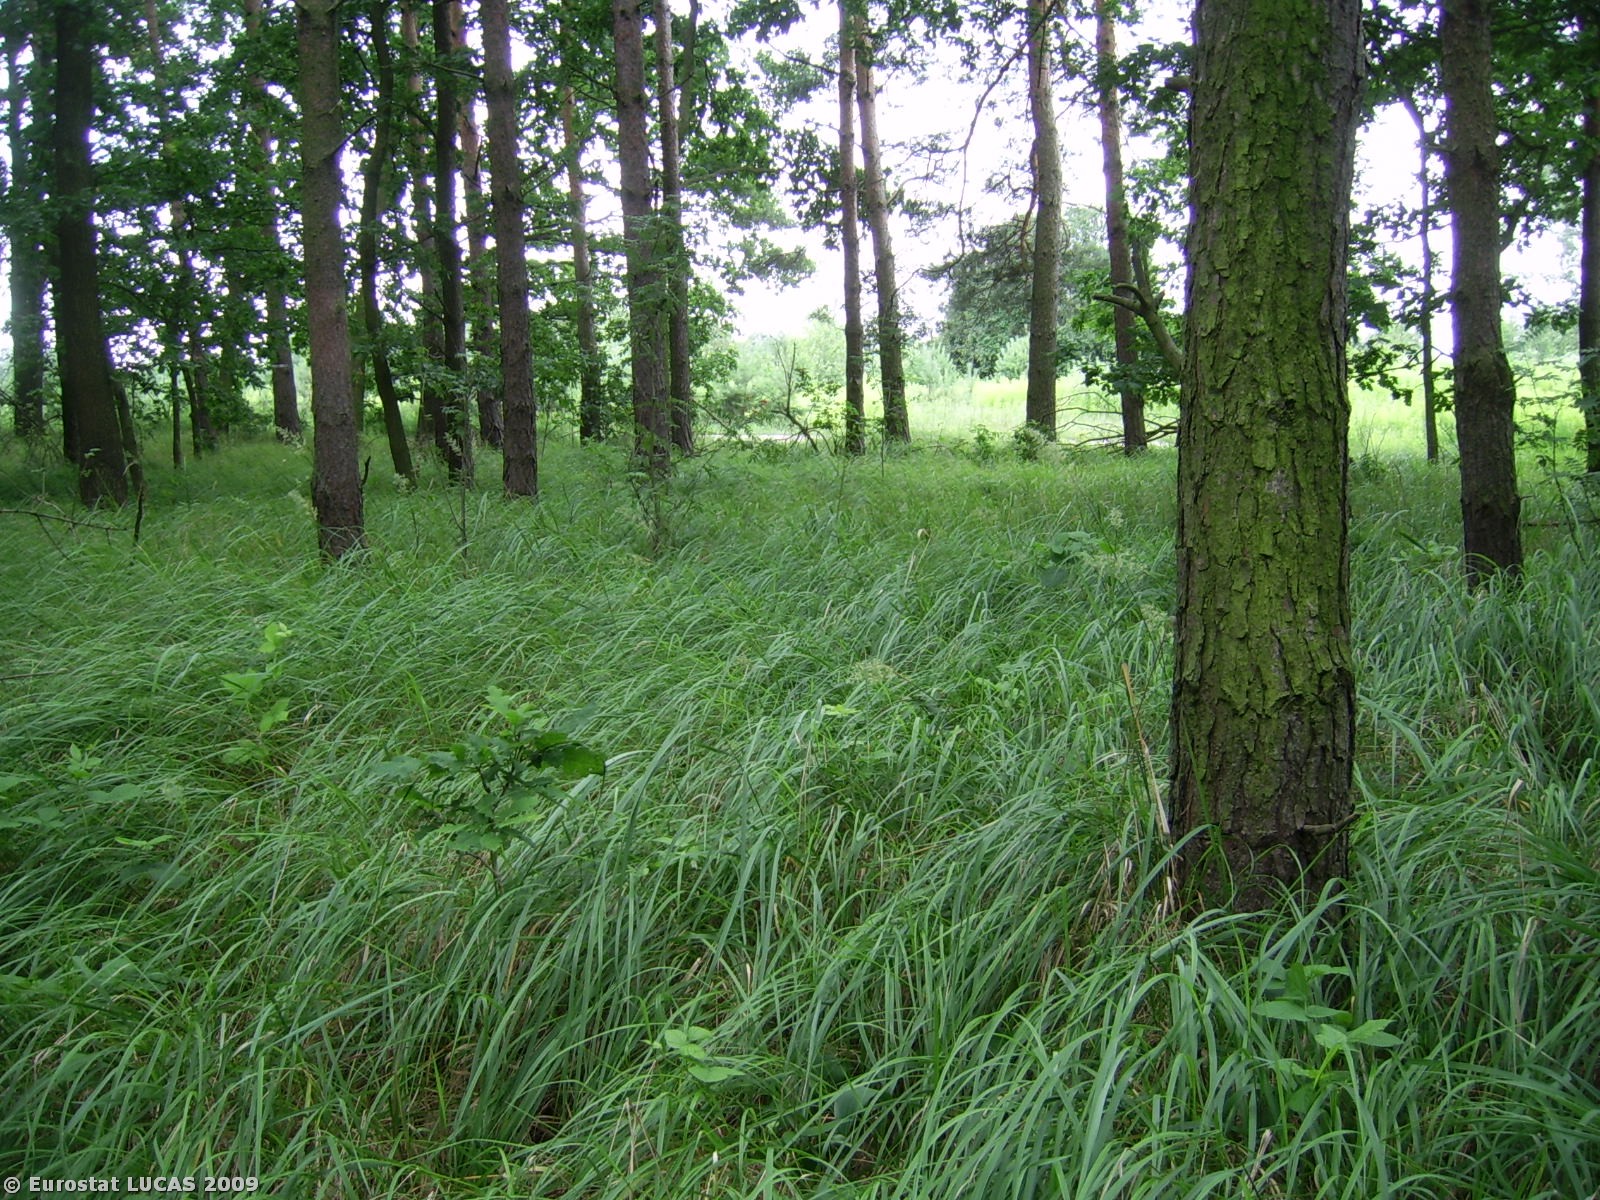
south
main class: Woodland
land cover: Mixed woodland
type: hemiboreal forest and nemoral coniferous forest and mixed broadleaved-coniferous forest
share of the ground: 50 - 75 %
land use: Unused
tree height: > 5 m
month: July
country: PL
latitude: 53.1757
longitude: 18.2305
